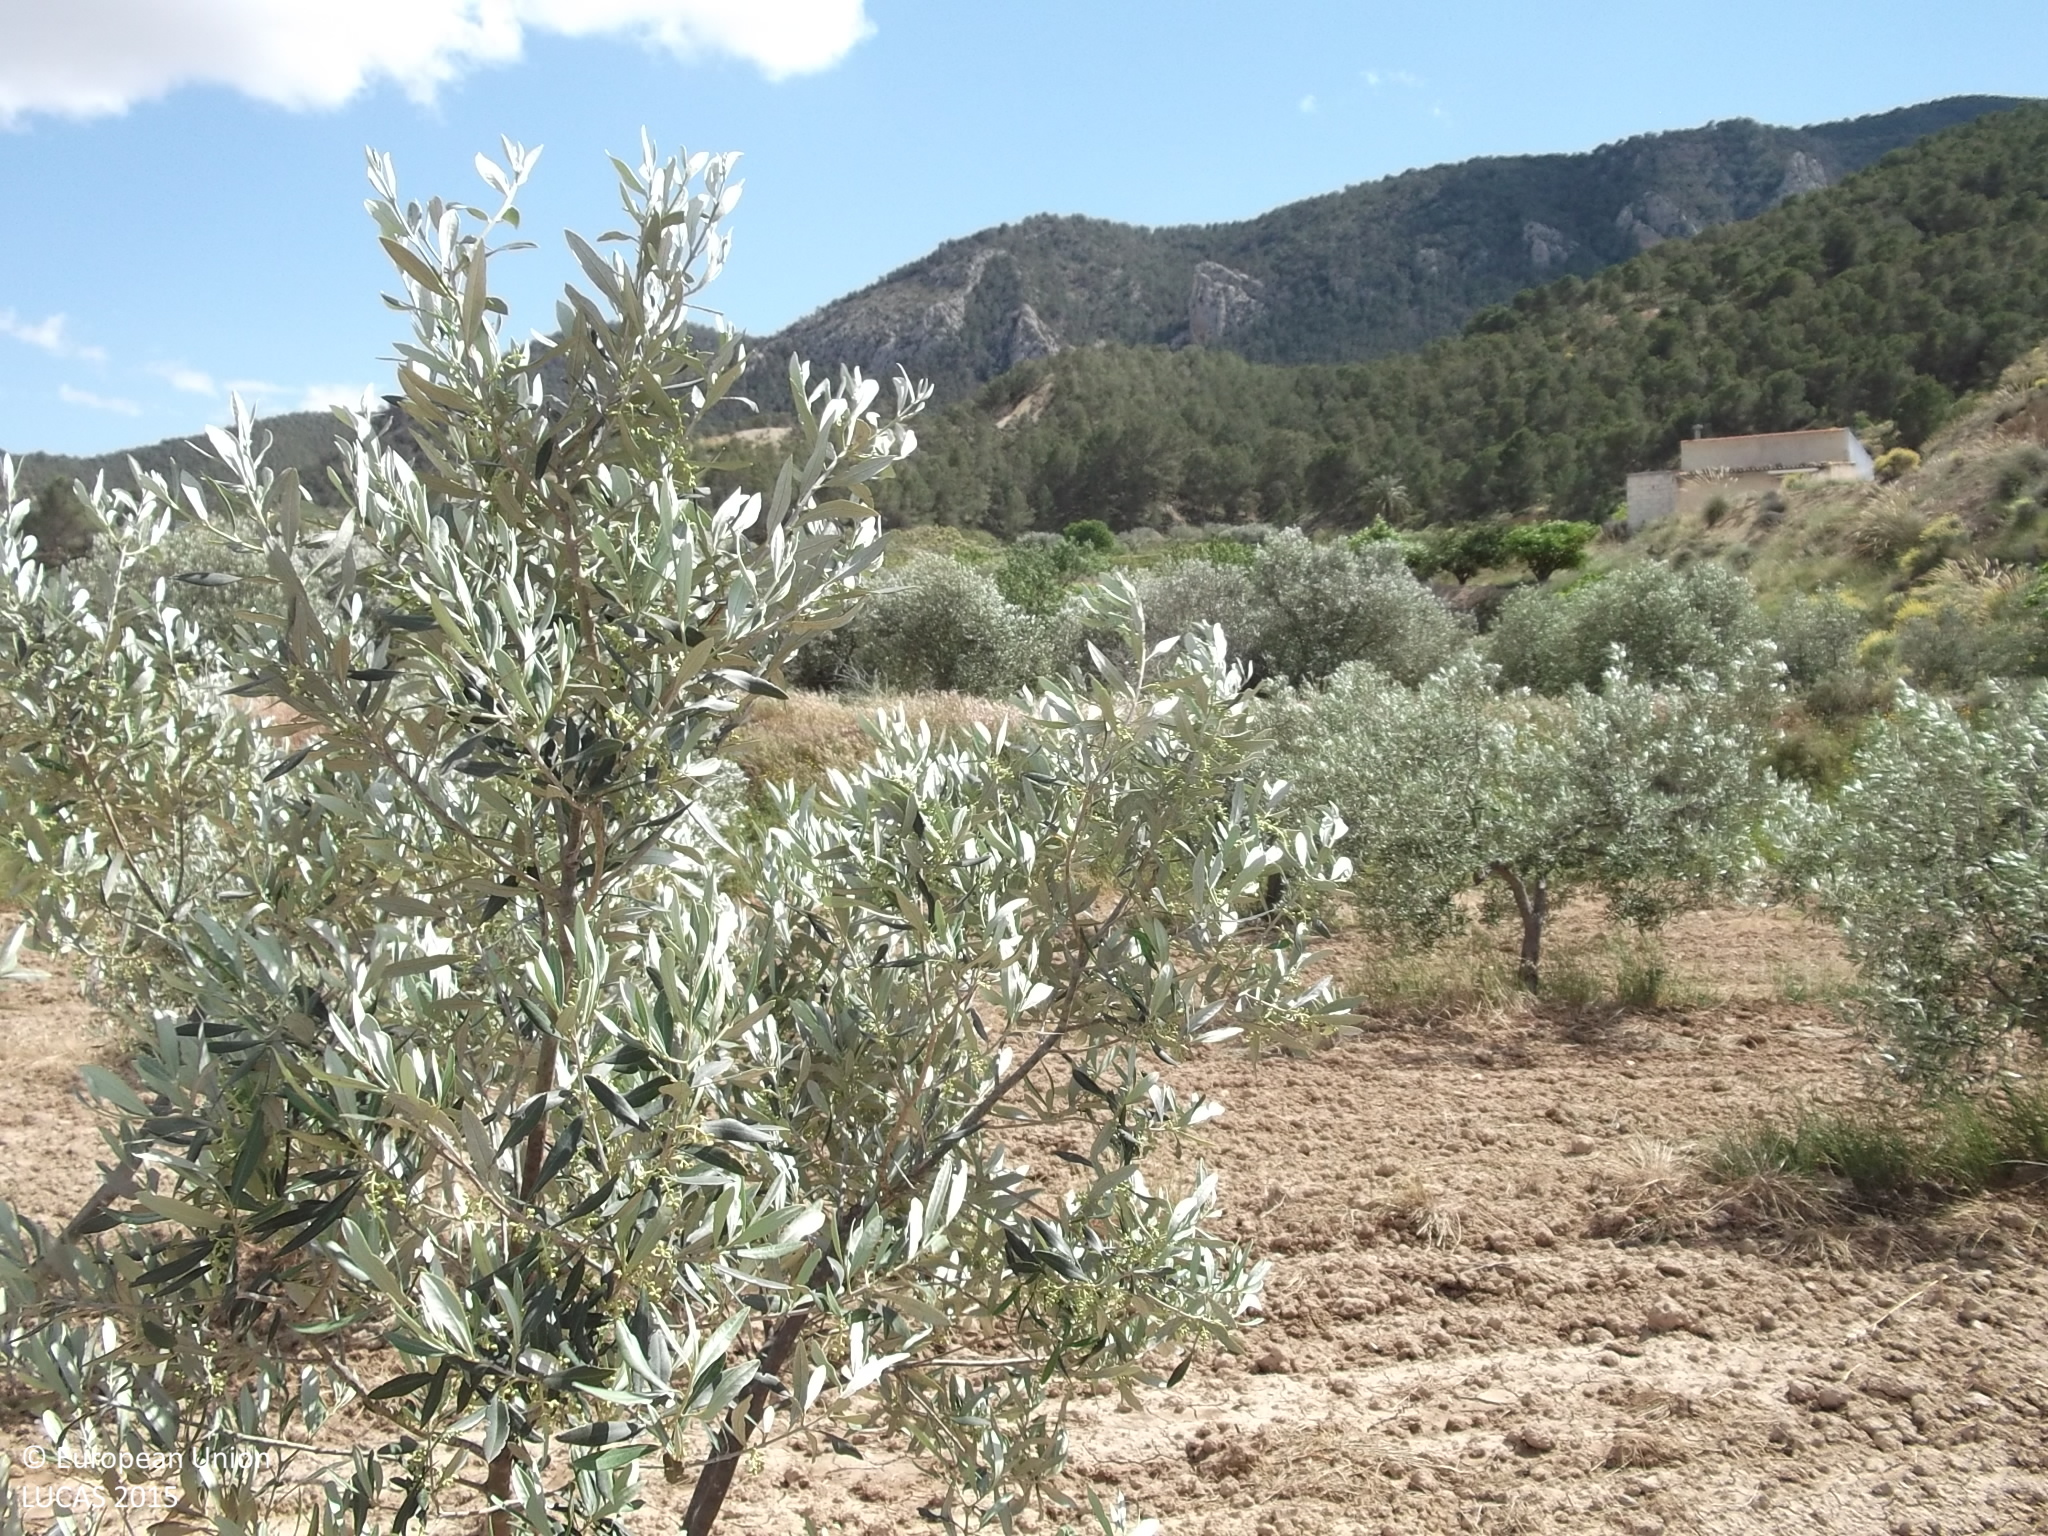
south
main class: Cropland
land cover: Olive groves
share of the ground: 10 - 25 %
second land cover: Other bare soil
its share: > 75 %
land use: Agriculture (excluding fallow land and kitchen gardens)
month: April
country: ES
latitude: 38.1586
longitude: -1.3884
